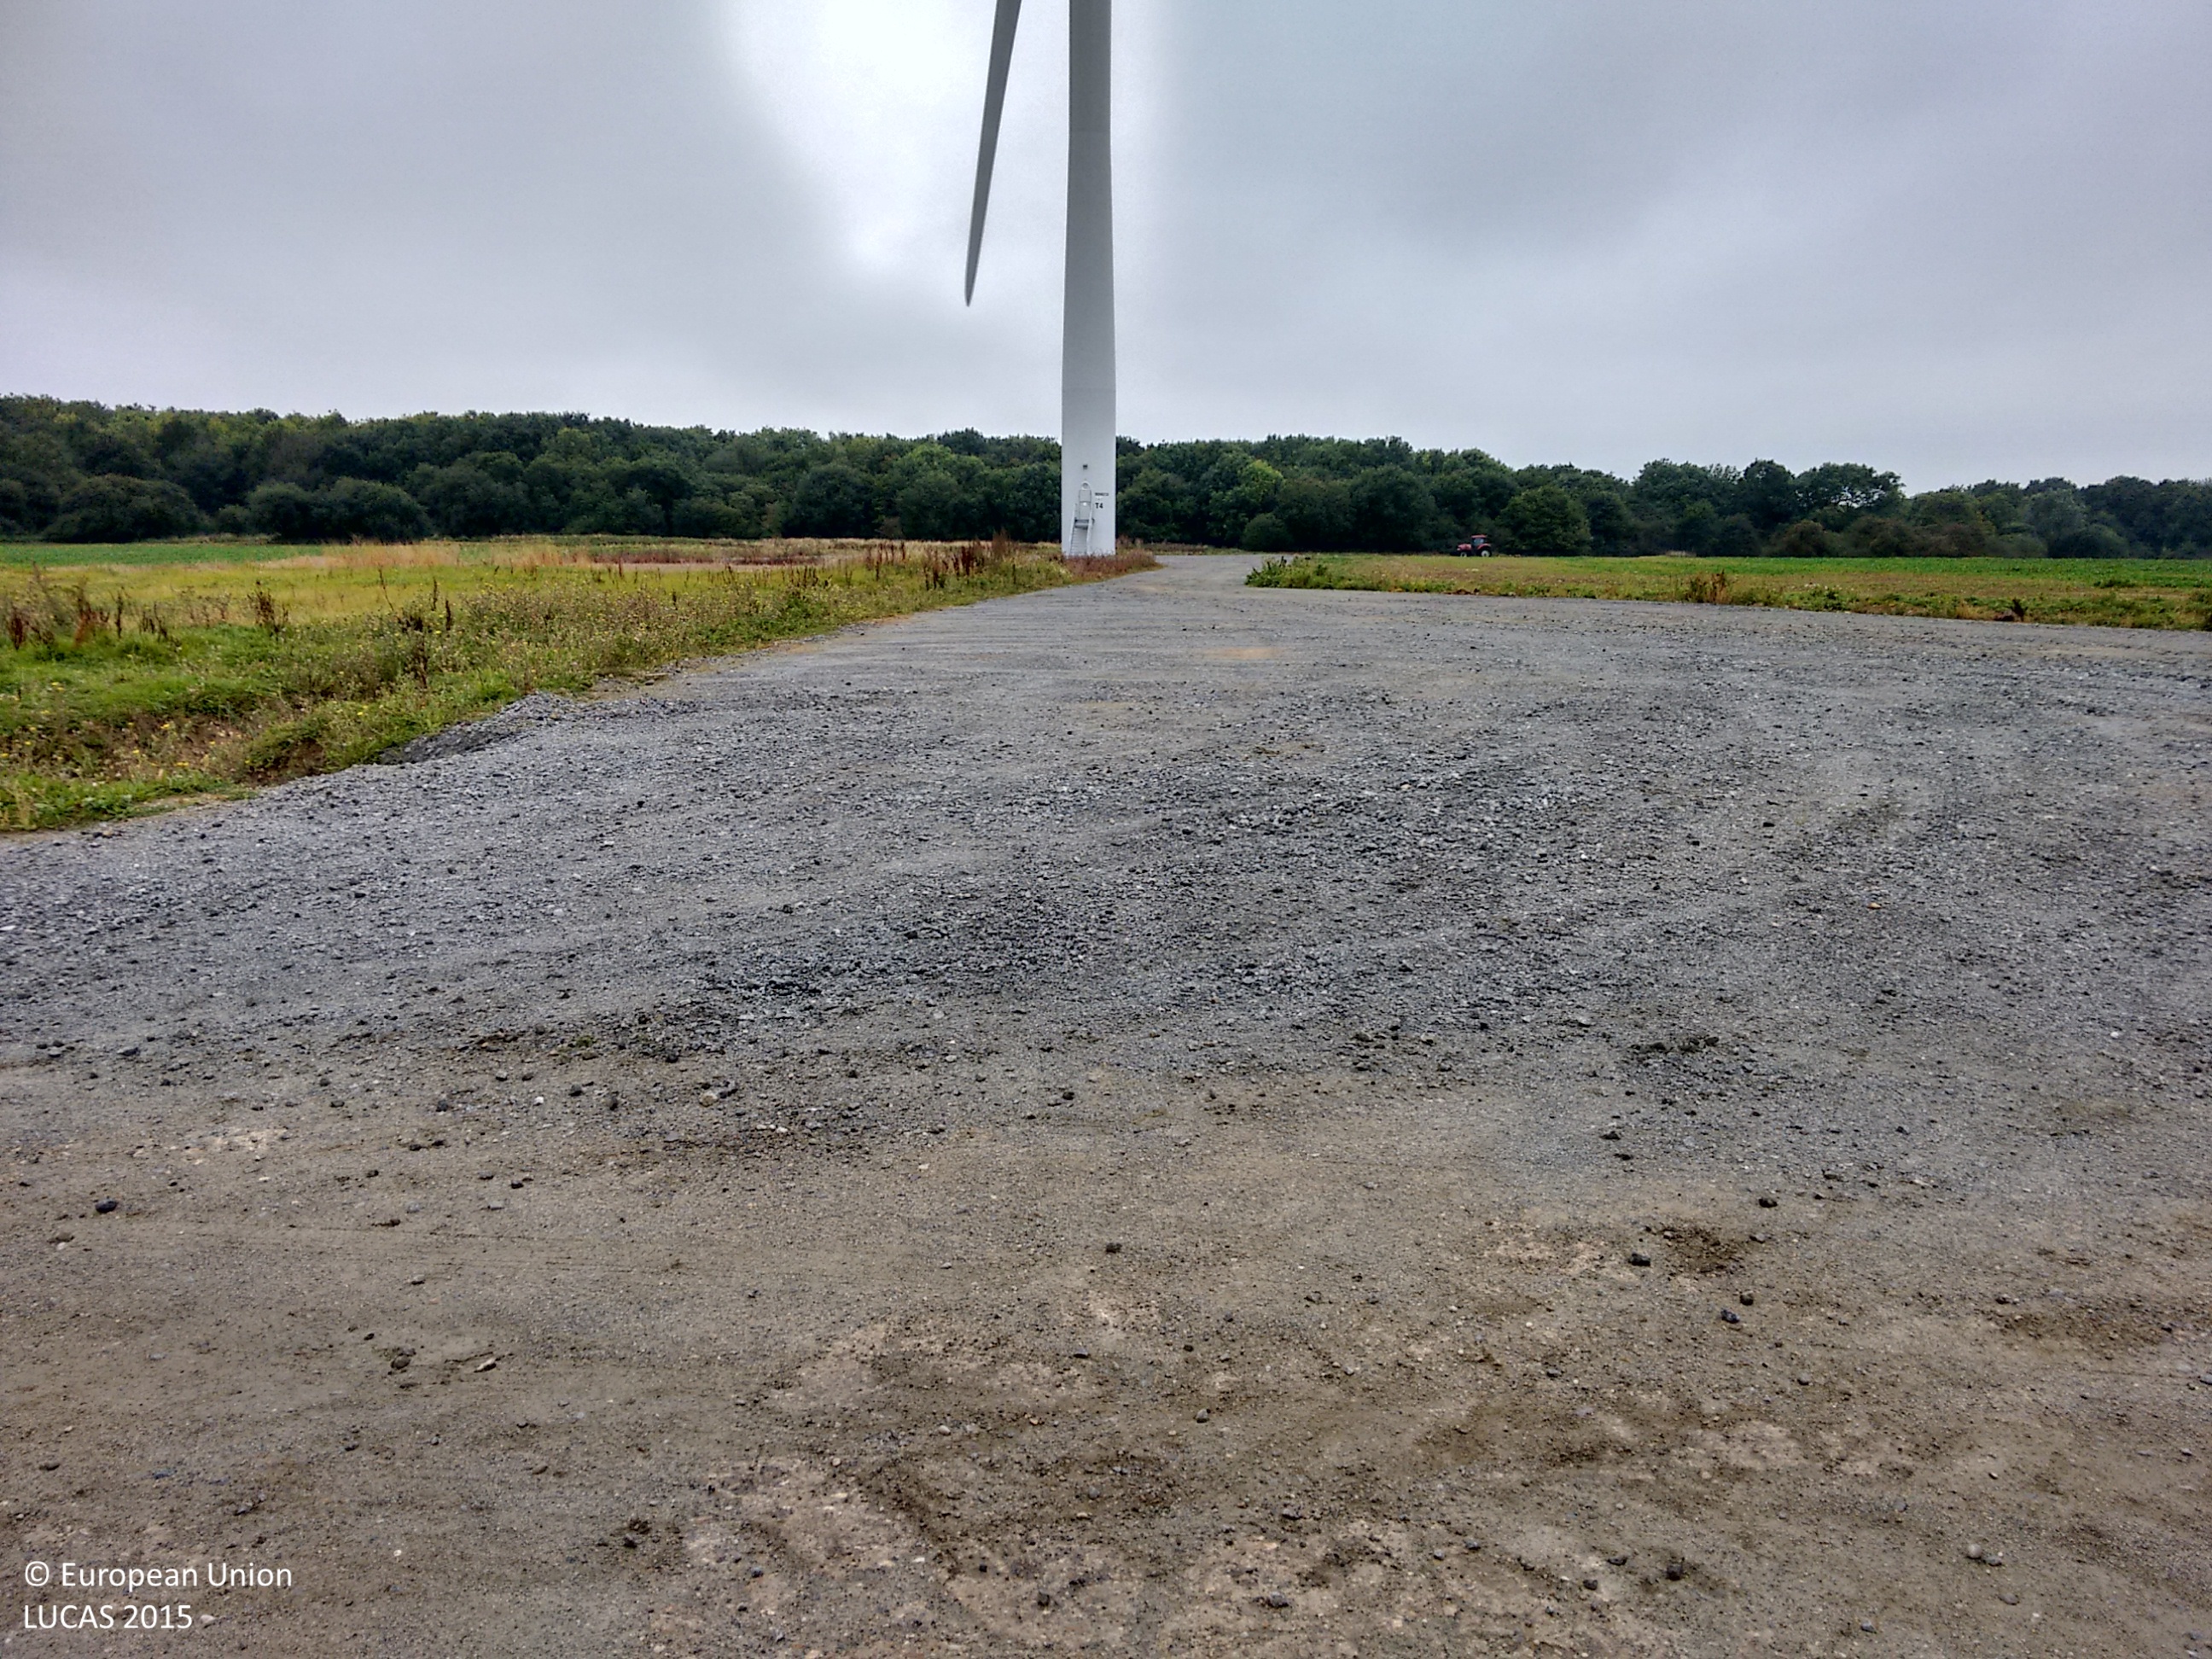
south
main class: Cropland
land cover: Rape and turnip rape
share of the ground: > 75 %
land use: Agriculture (excluding fallow land and kitchen gardens)
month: October
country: GB
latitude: 52.3642
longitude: 1.5370
